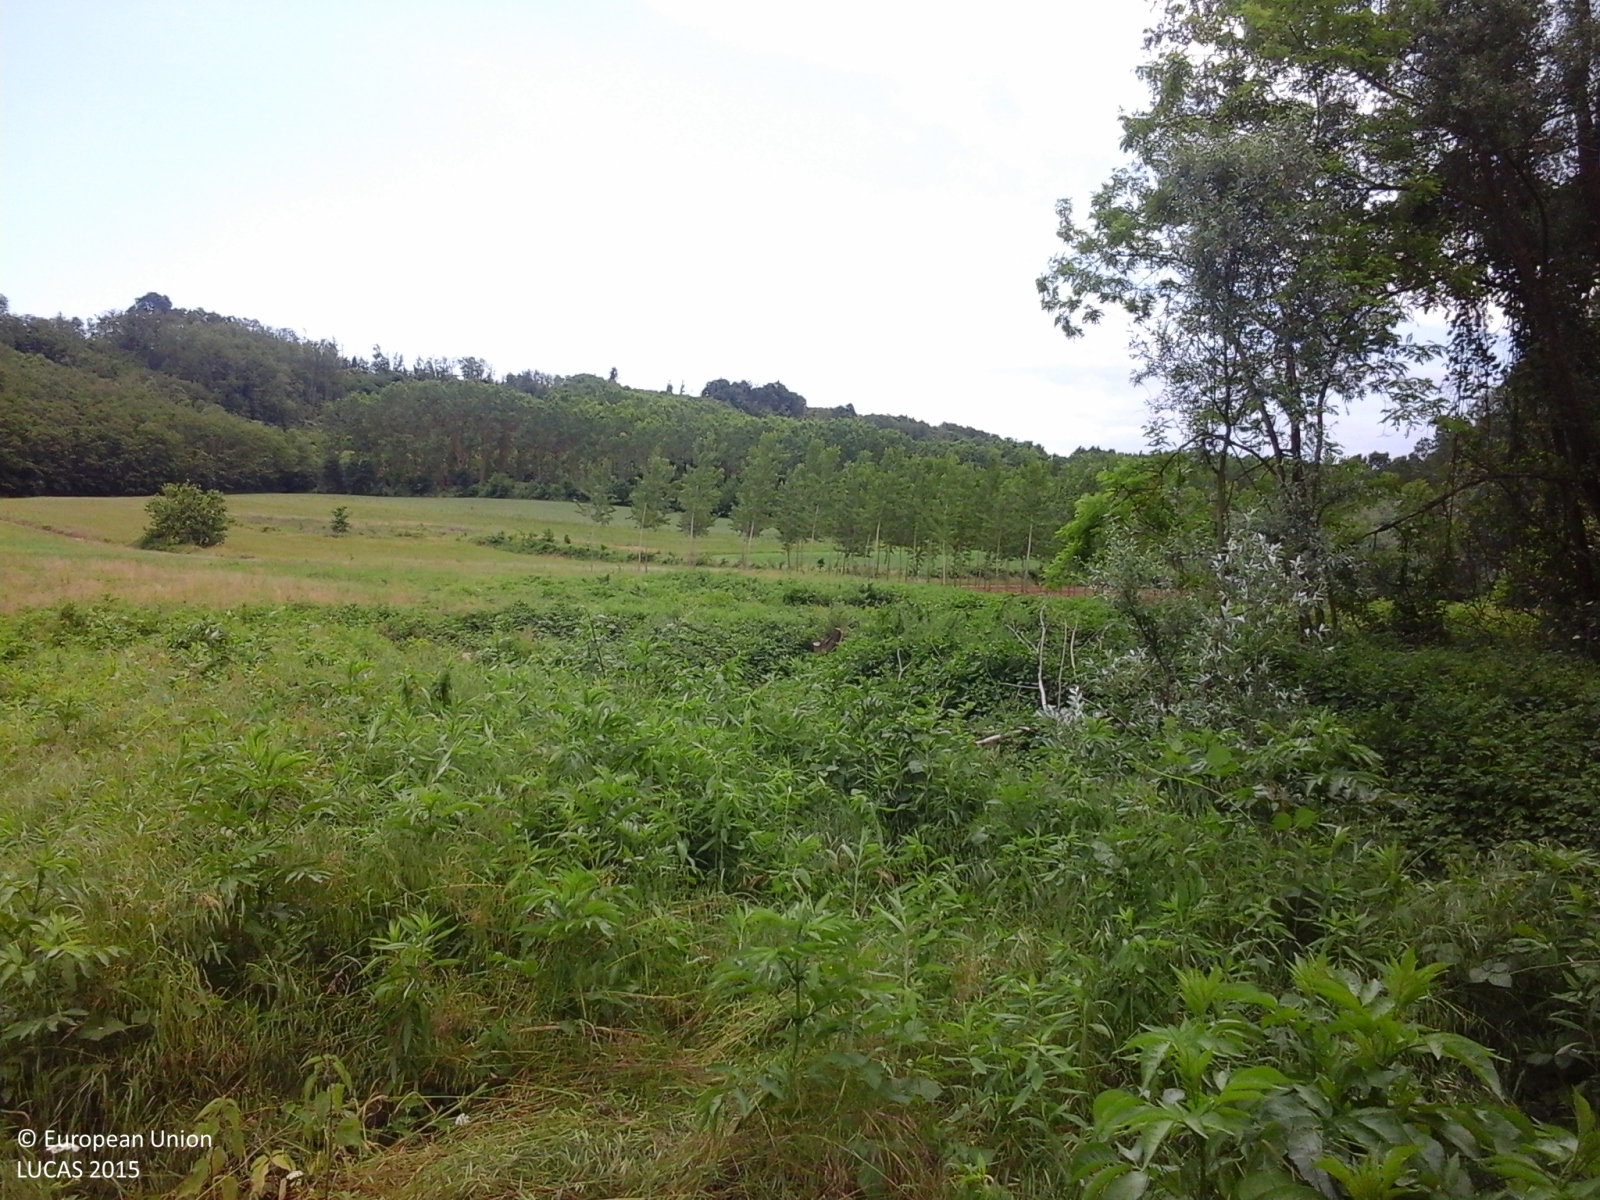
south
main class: Woodland
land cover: Broadleaved woodland
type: mesophytic deciduous forest
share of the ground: > 75 %
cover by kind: broadleaved forest trees 80 %, shrubs 10 %, herbaceous plants 10 %
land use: Forestry
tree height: > 5 m
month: May
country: IT
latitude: 44.8432
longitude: 8.3964
